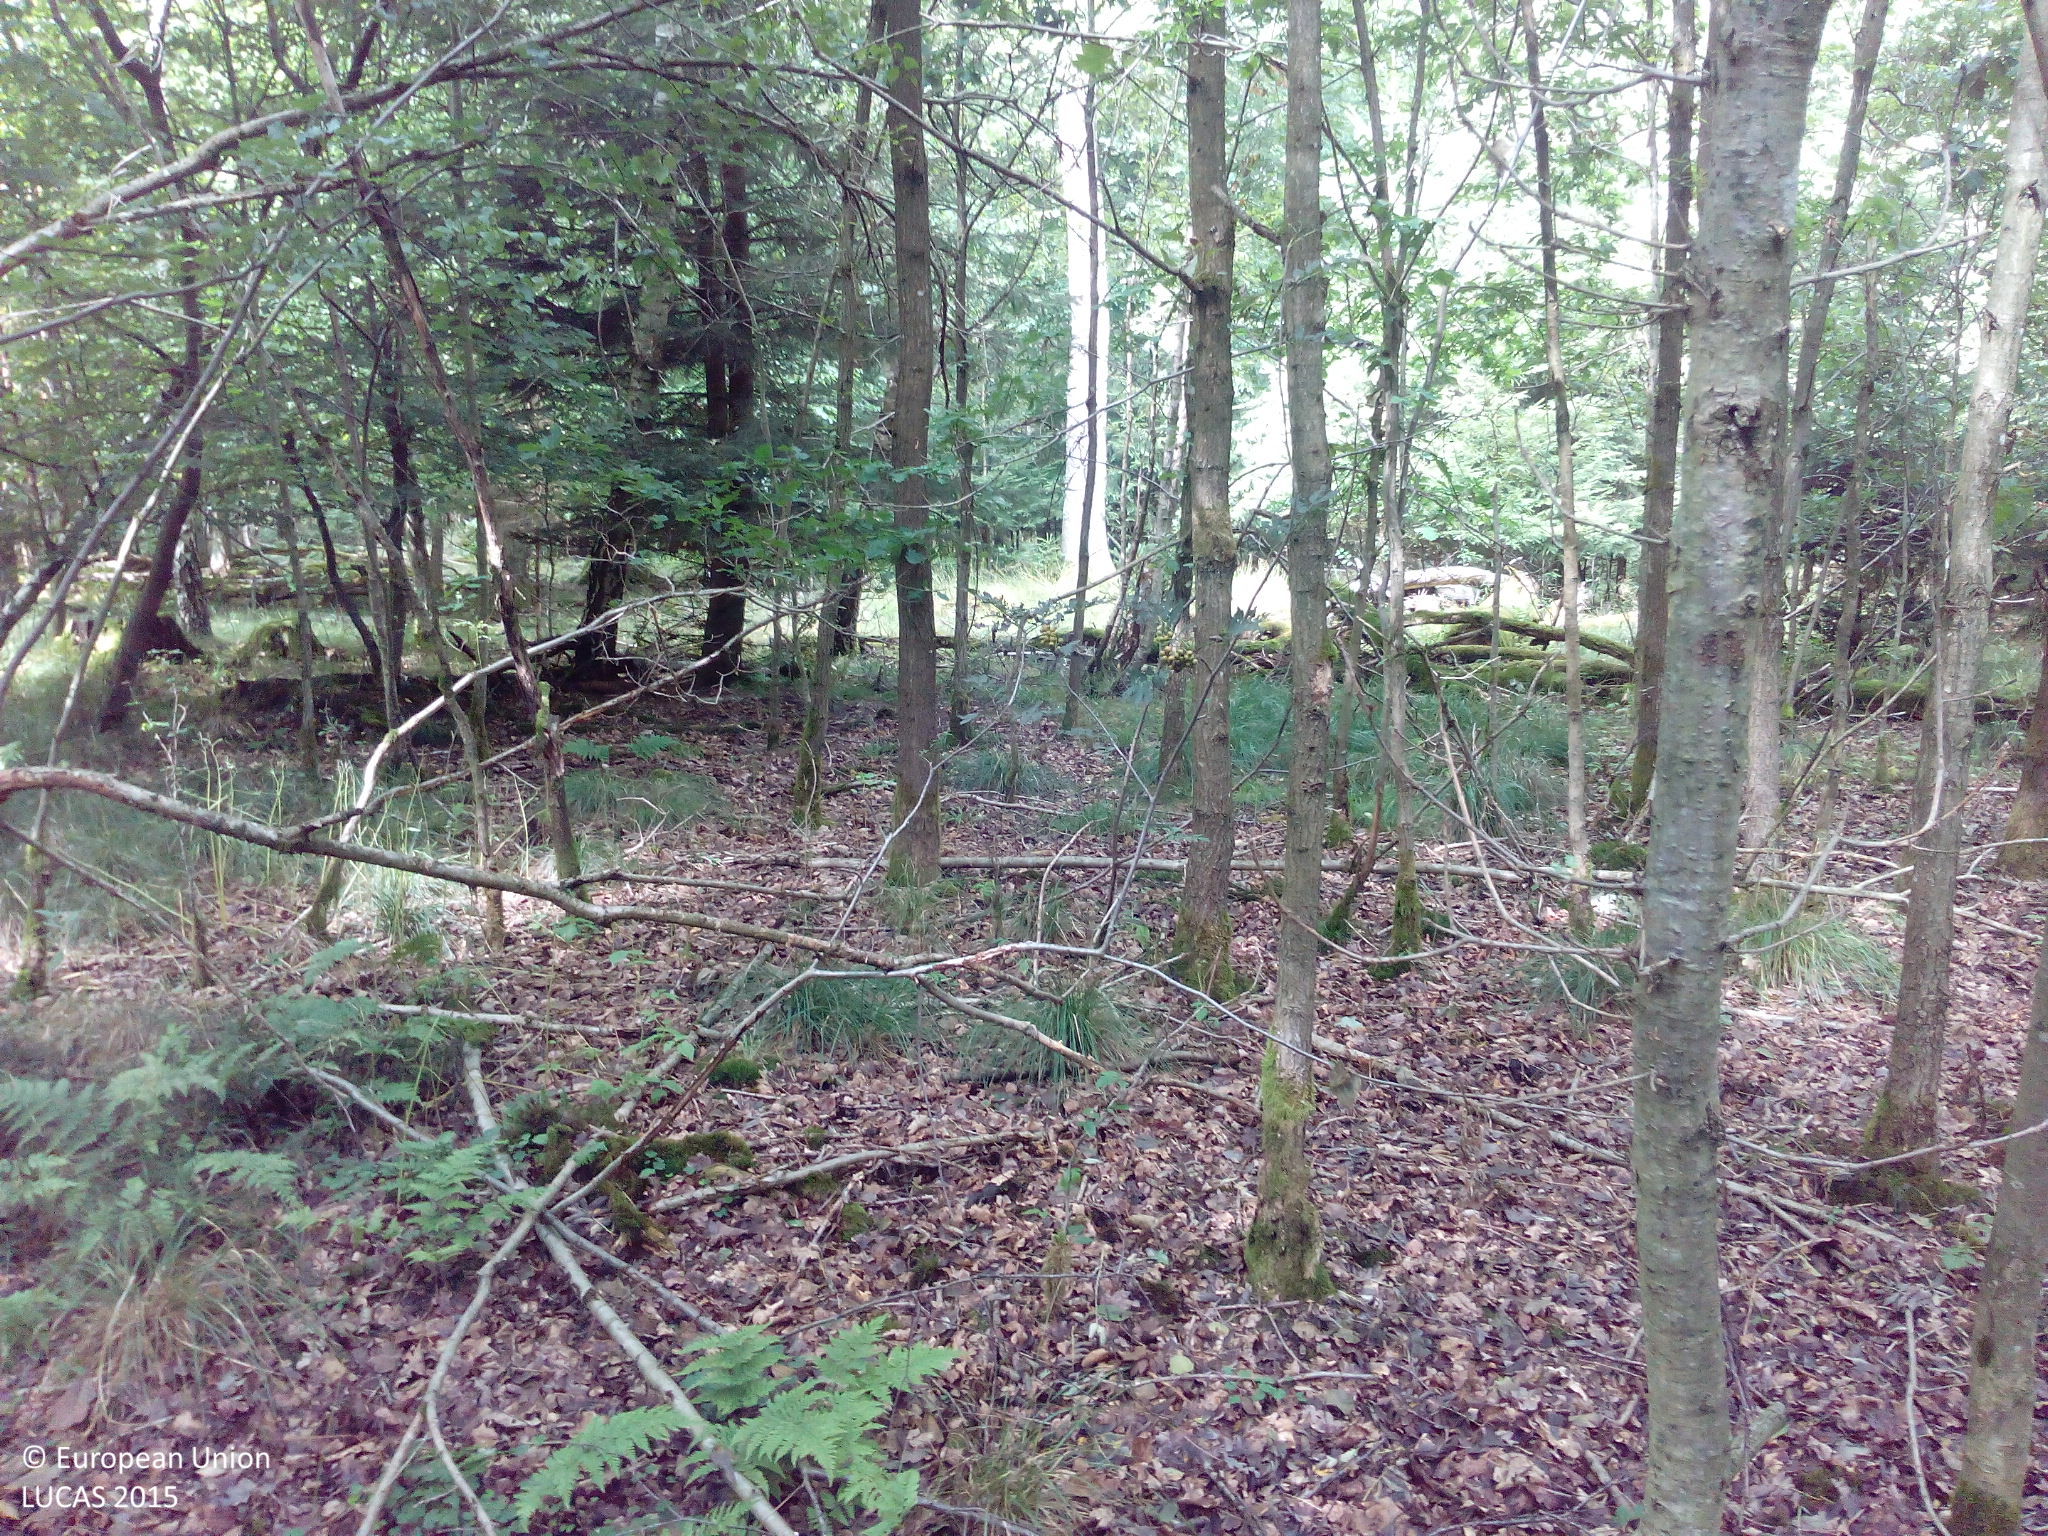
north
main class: Woodland
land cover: Broadleaved woodland
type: mesophytic deciduous forest
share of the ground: > 75 %
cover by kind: broadleaved forest trees 80 %, coniferous forest trees 5 %, herbaceous plants 5 %, lichens and mosses 5 %, unconsolidated bare surface 5 %
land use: Forestry
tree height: > 5 m
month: August
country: DE
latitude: 50.0675
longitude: 7.5275
